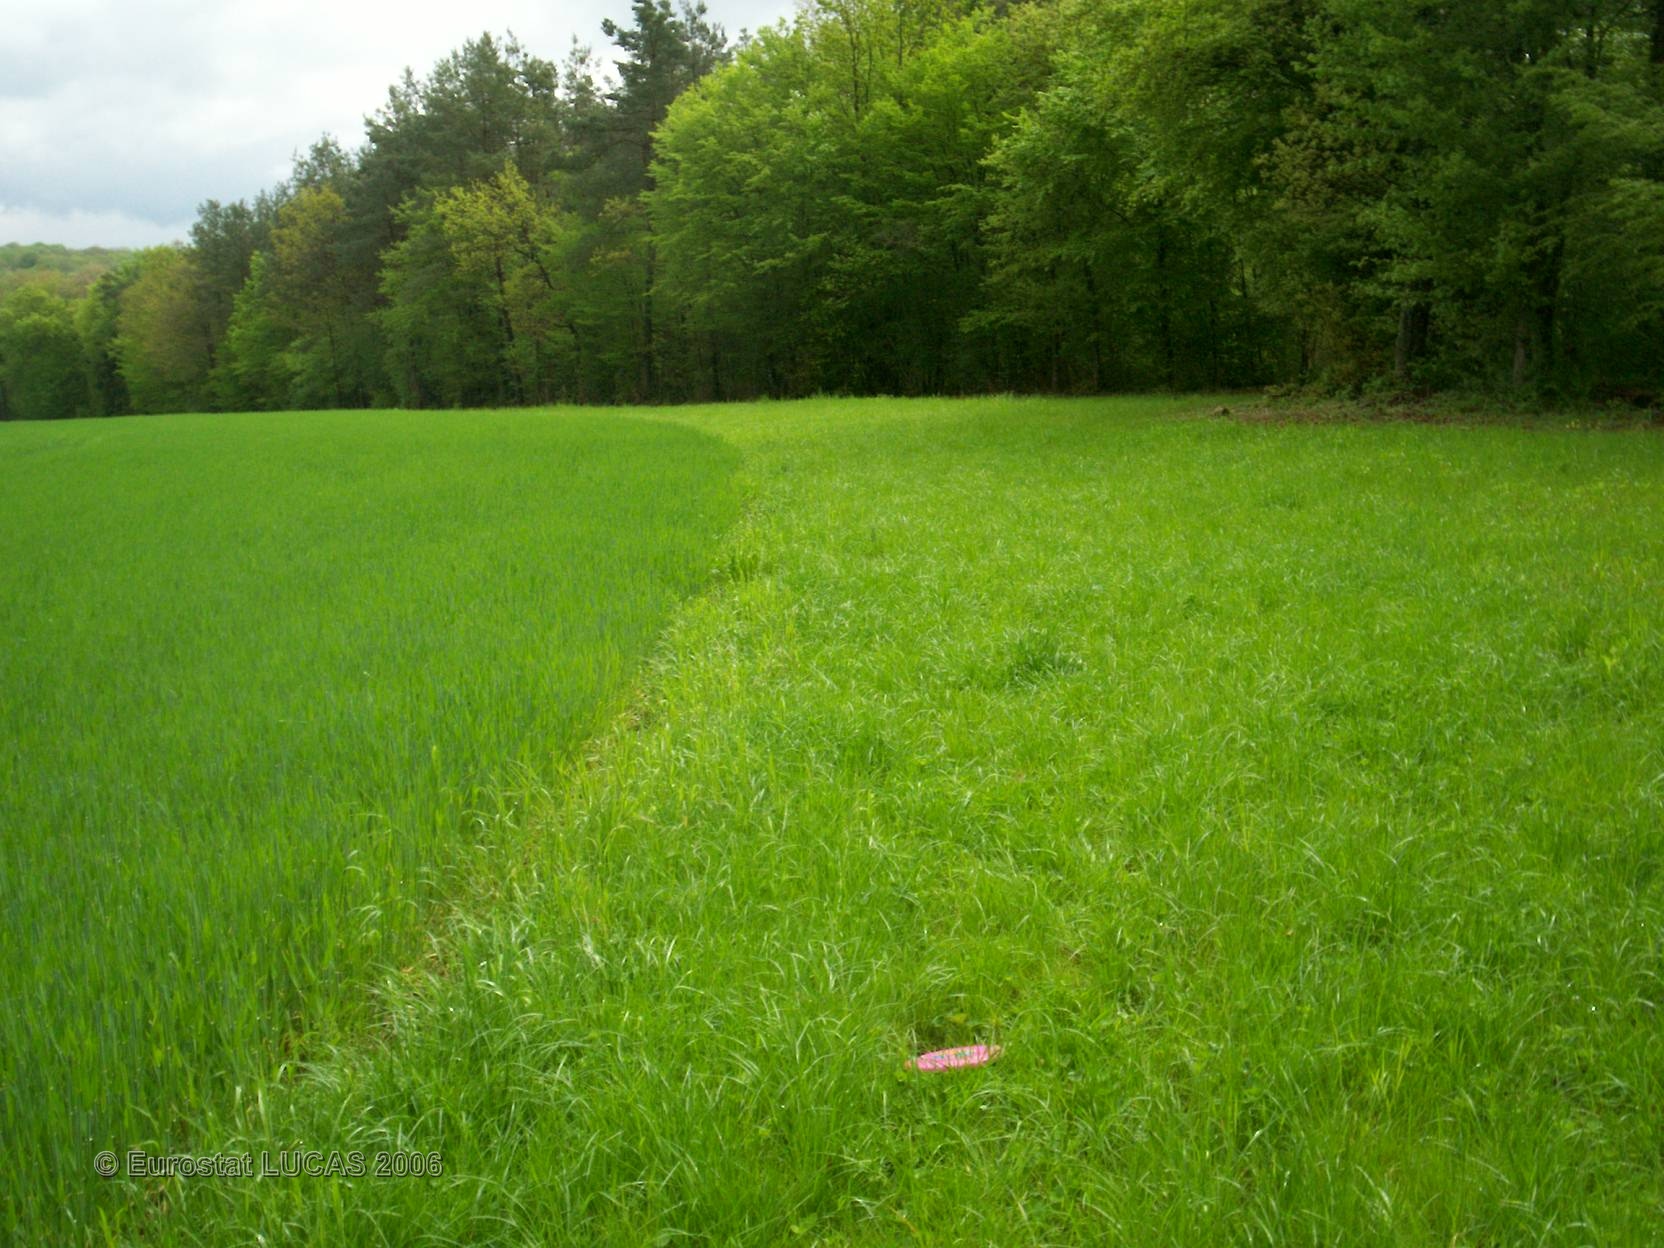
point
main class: Grassland
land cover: Grassland without tree/shrub cover
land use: Agriculture (excluding fallow land and kitchen gardens)
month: May
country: FR
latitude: 47.7663
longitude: 4.5950
